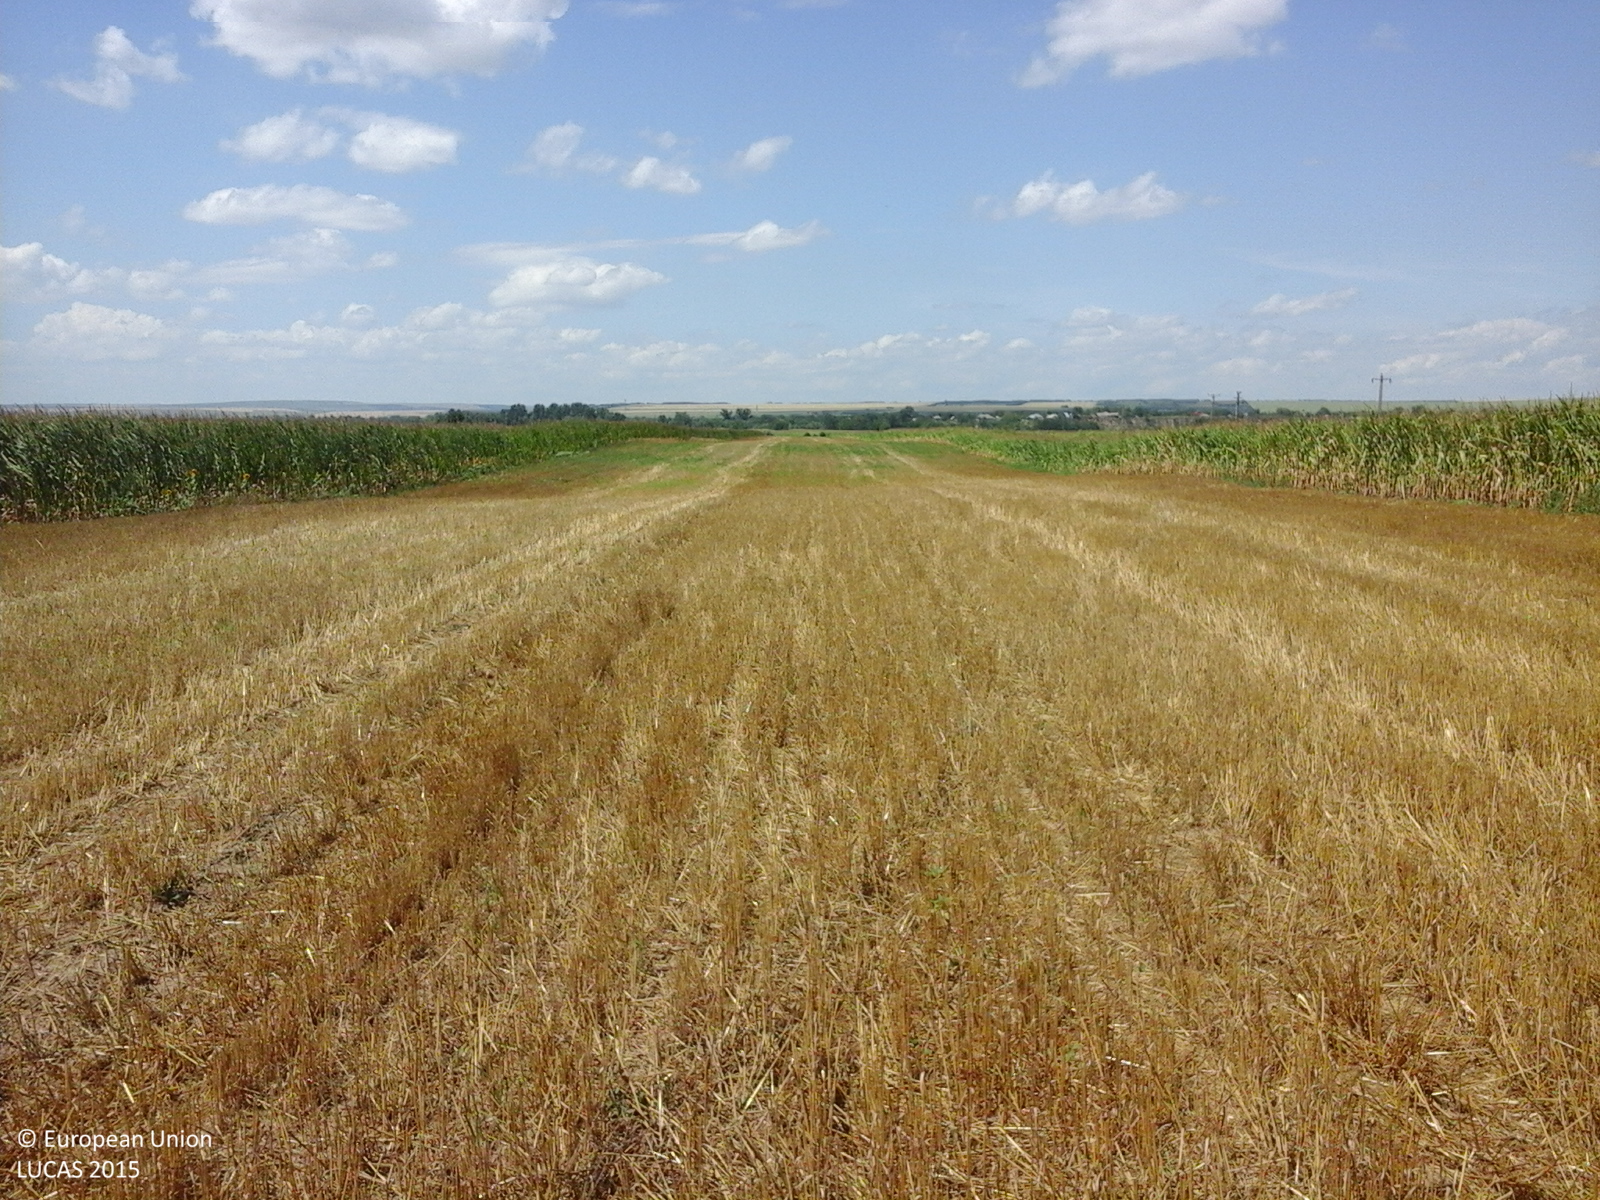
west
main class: Cropland
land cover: Common wheat
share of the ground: 50 - 75 %
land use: Agriculture (excluding fallow land and kitchen gardens)
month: July
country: RO
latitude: 46.4268
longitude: 28.2343
